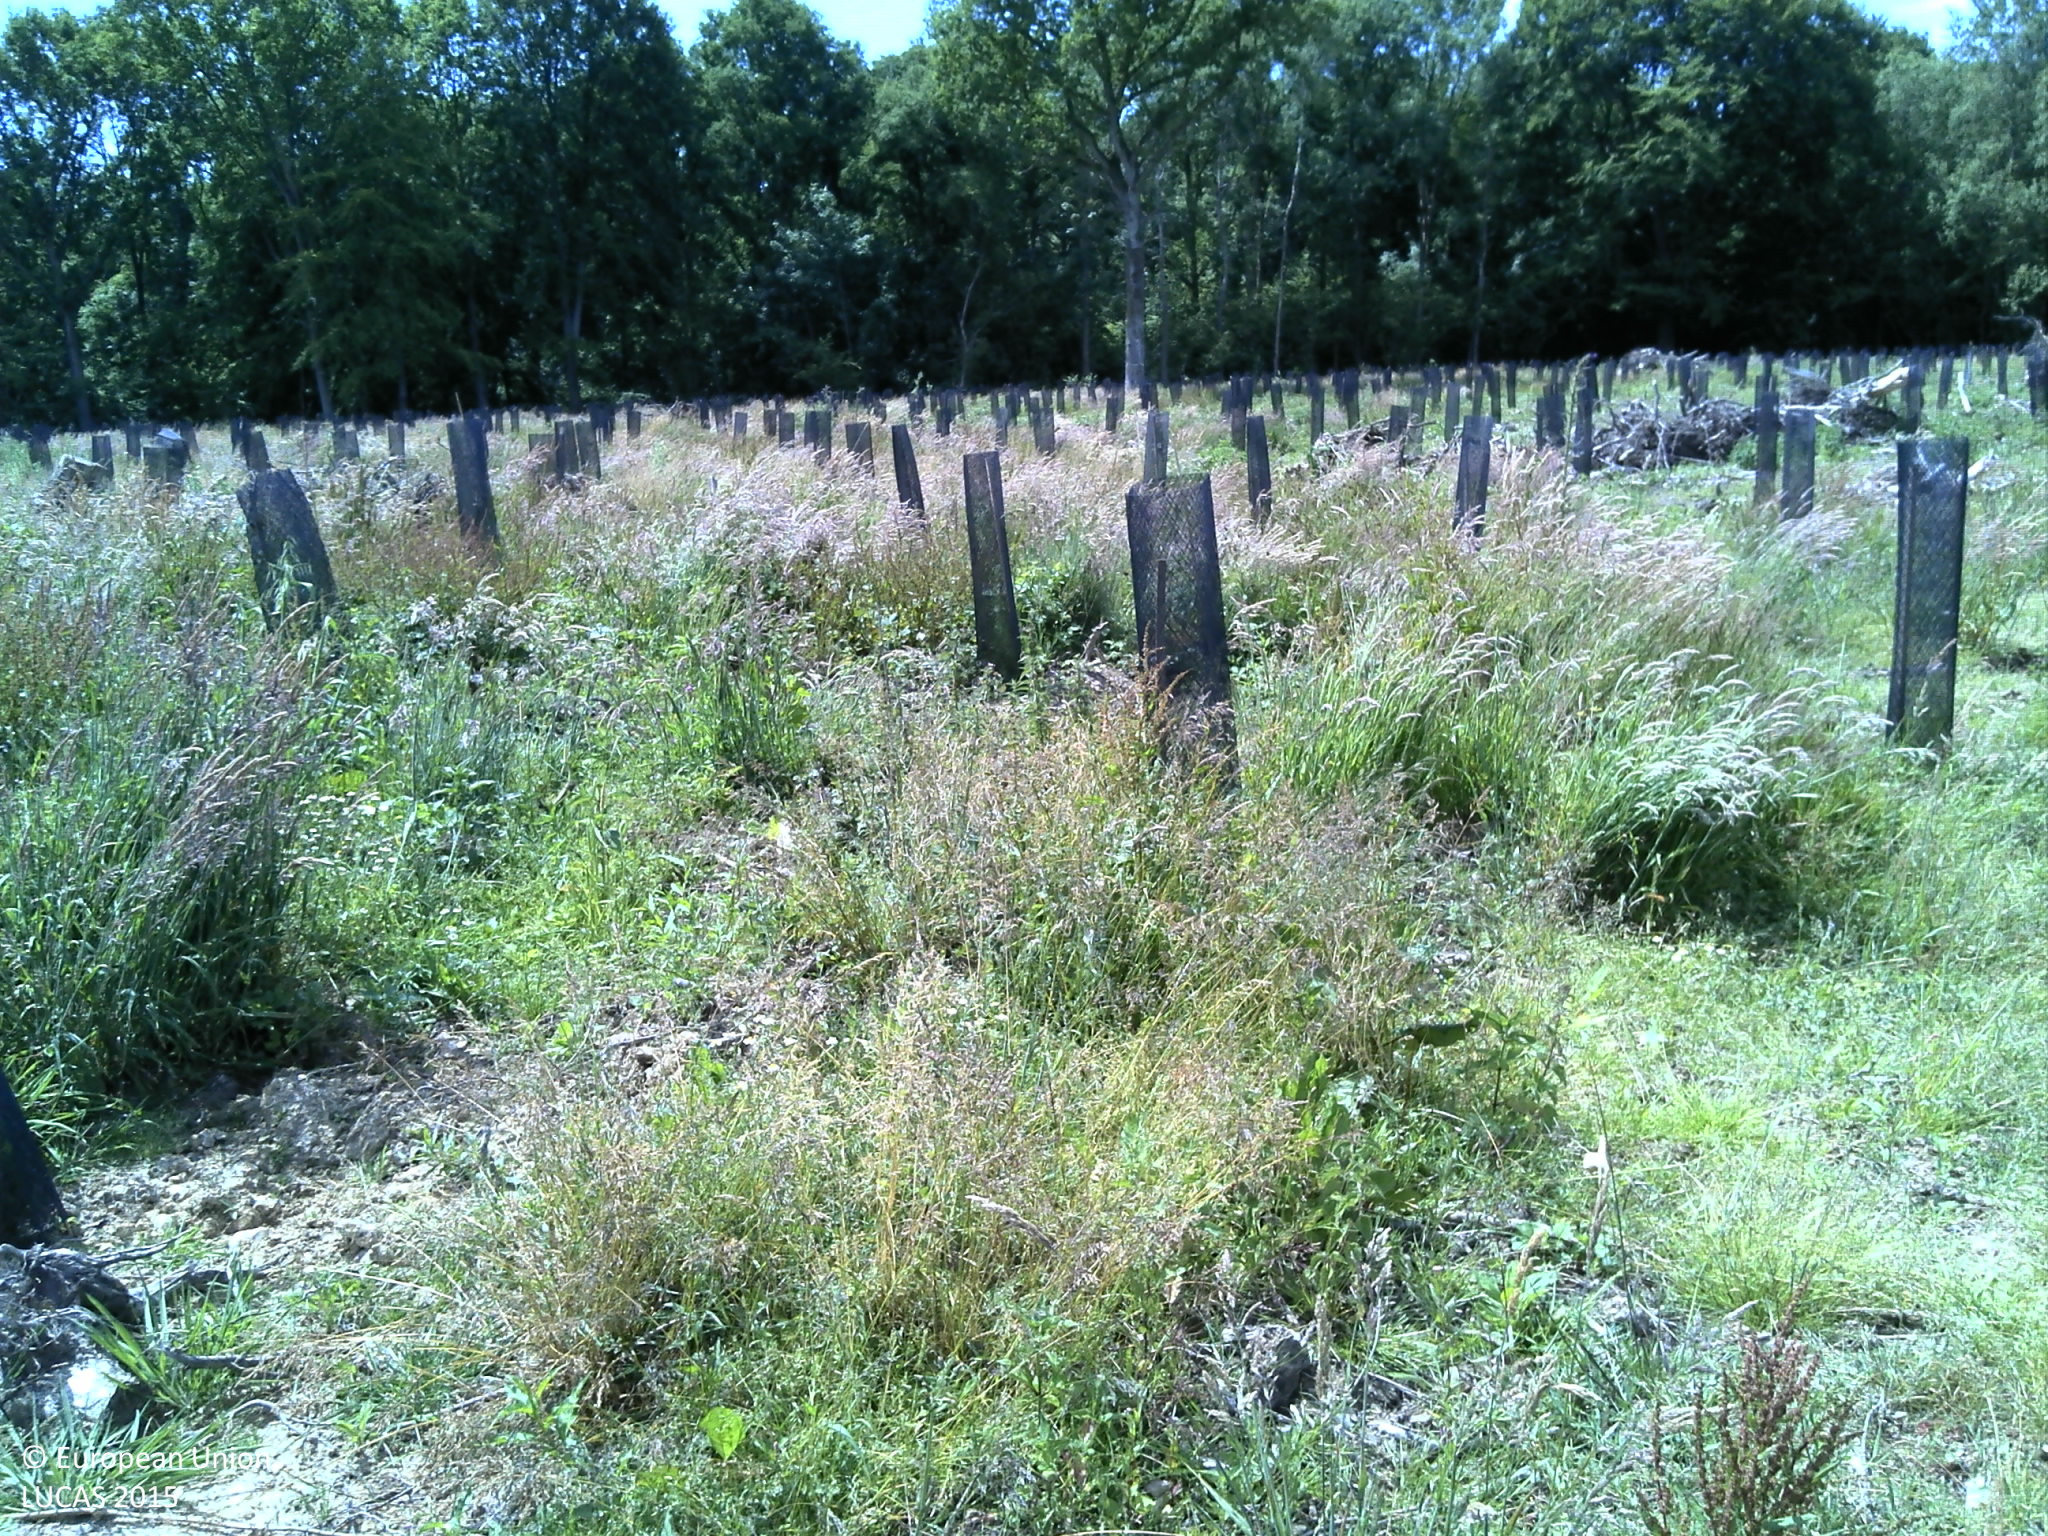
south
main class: Cropland
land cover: Nurseries
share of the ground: < 10 %
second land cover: Spontaneously vegetated surfaces
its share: > 75 %
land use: Forestry
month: June
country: FR
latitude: 49.7507
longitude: 0.9415
